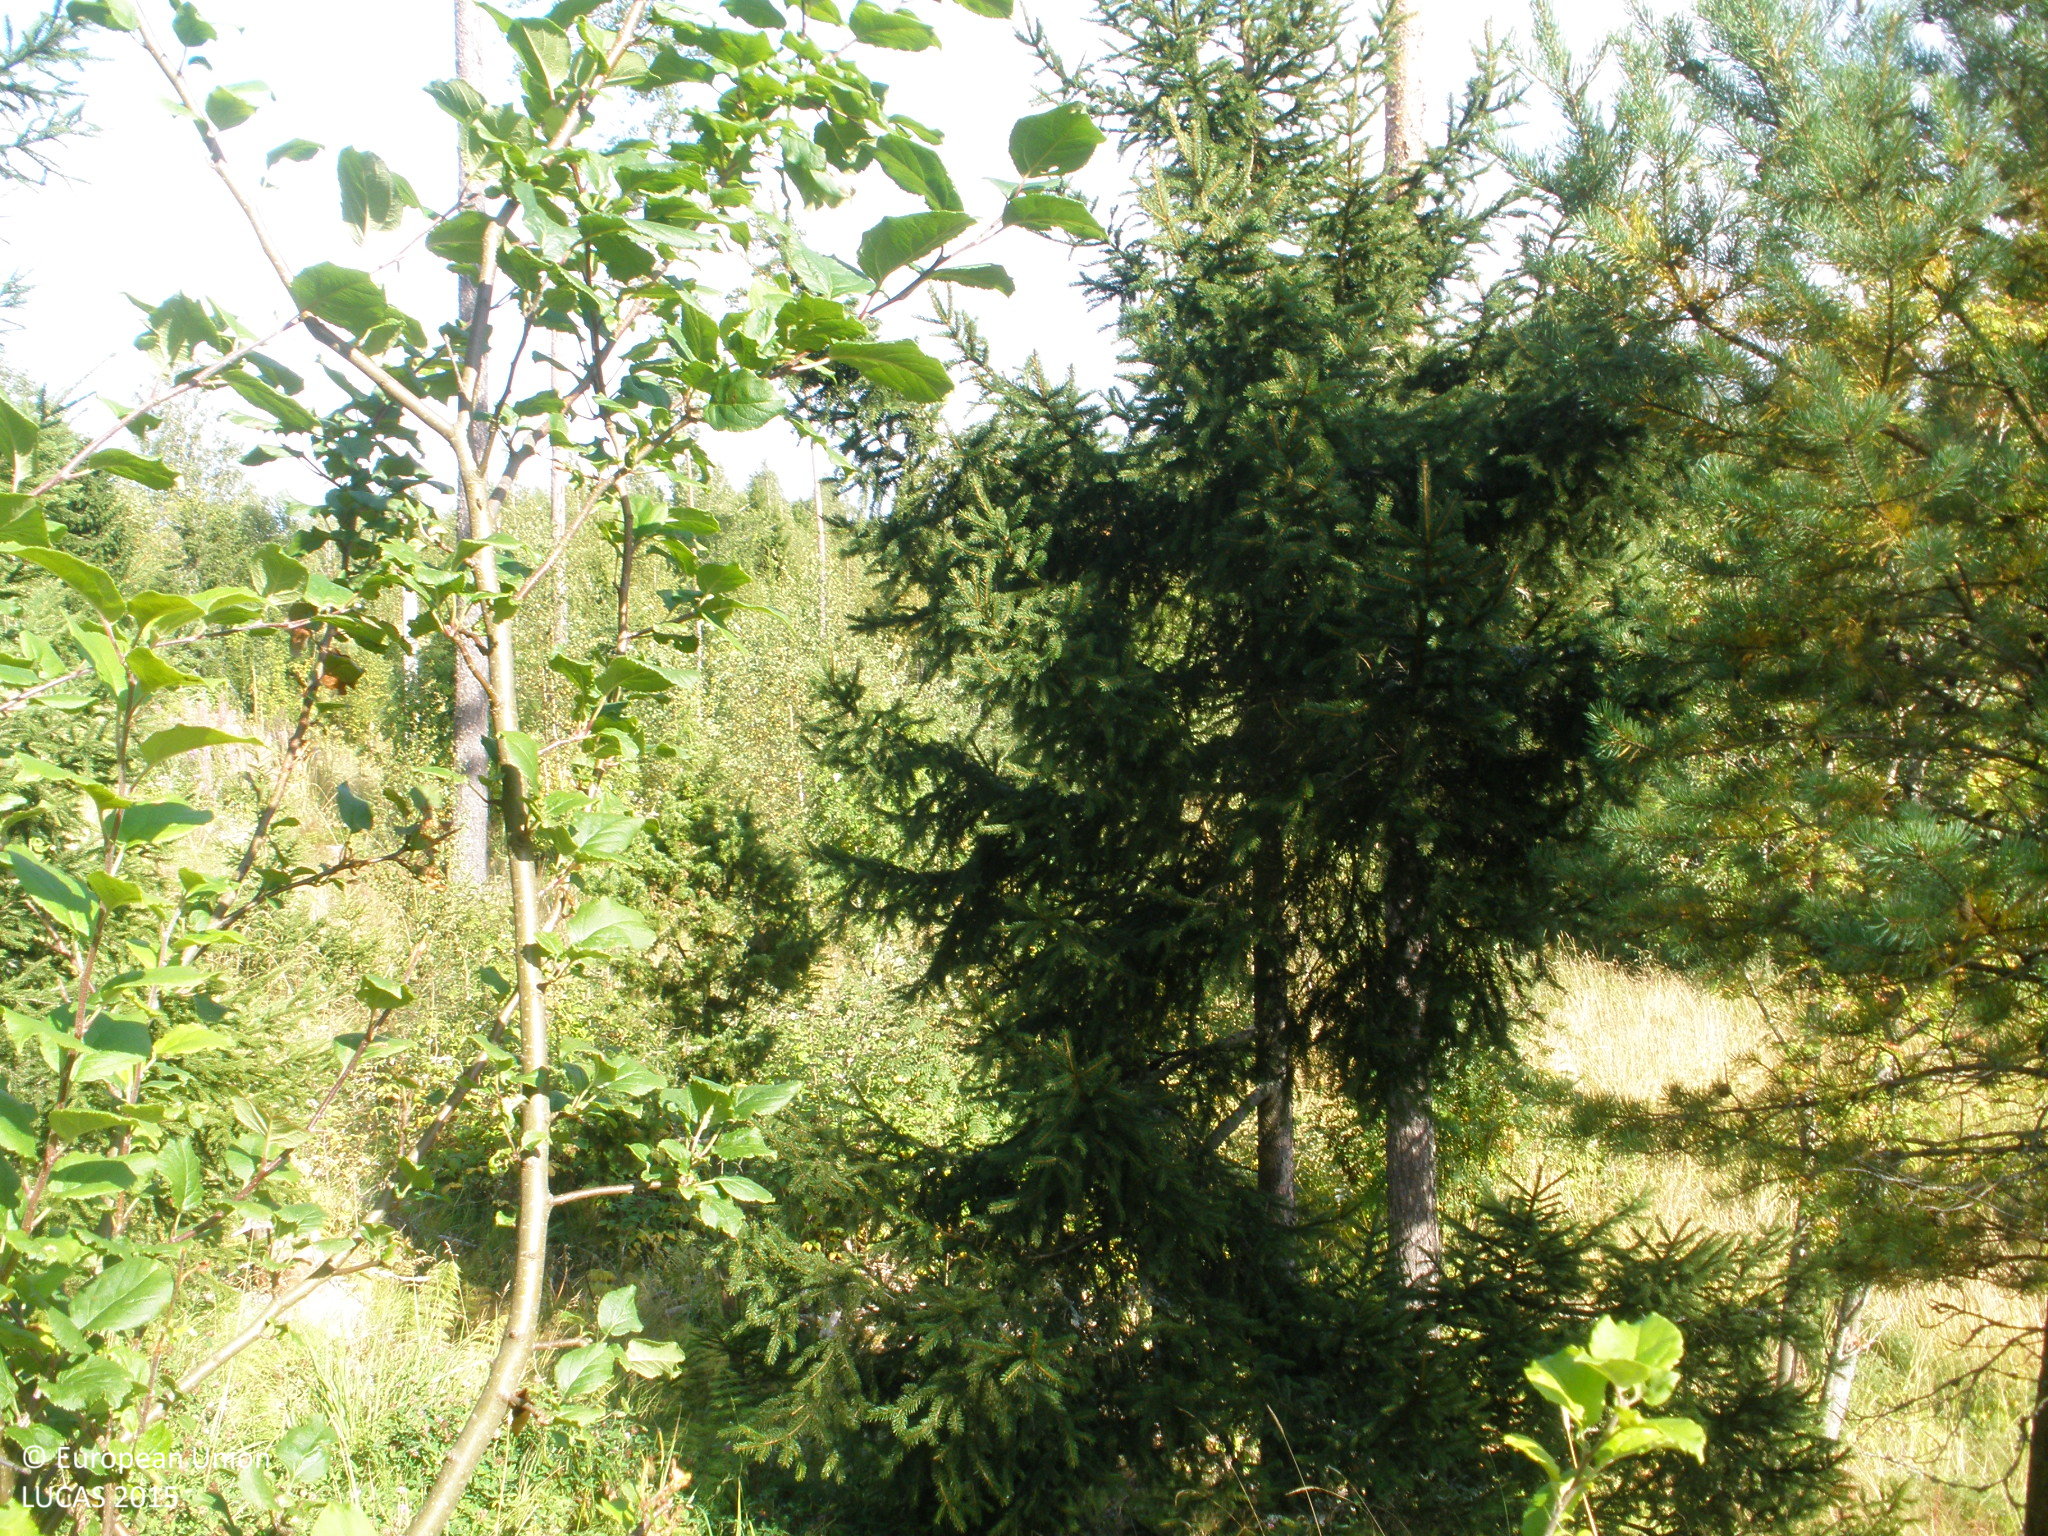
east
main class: Grassland
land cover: Grassland with sparse tree/shrub cover
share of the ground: > 75 %
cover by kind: herbaceous plants 85 %, broadleaved forest trees 5 %, shrubs 5 %, unconsolidated bare surface 5 %
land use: Agriculture (excluding fallow land and kitchen gardens)
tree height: < 5 m
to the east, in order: Grassland with sparse tree/shrub cover; Fences; Rivers and streams; Other mixed woodland; Tracks; Other mixed woodland; Temporary grasslands
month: August
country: FI
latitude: 60.6027
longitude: 23.3609
